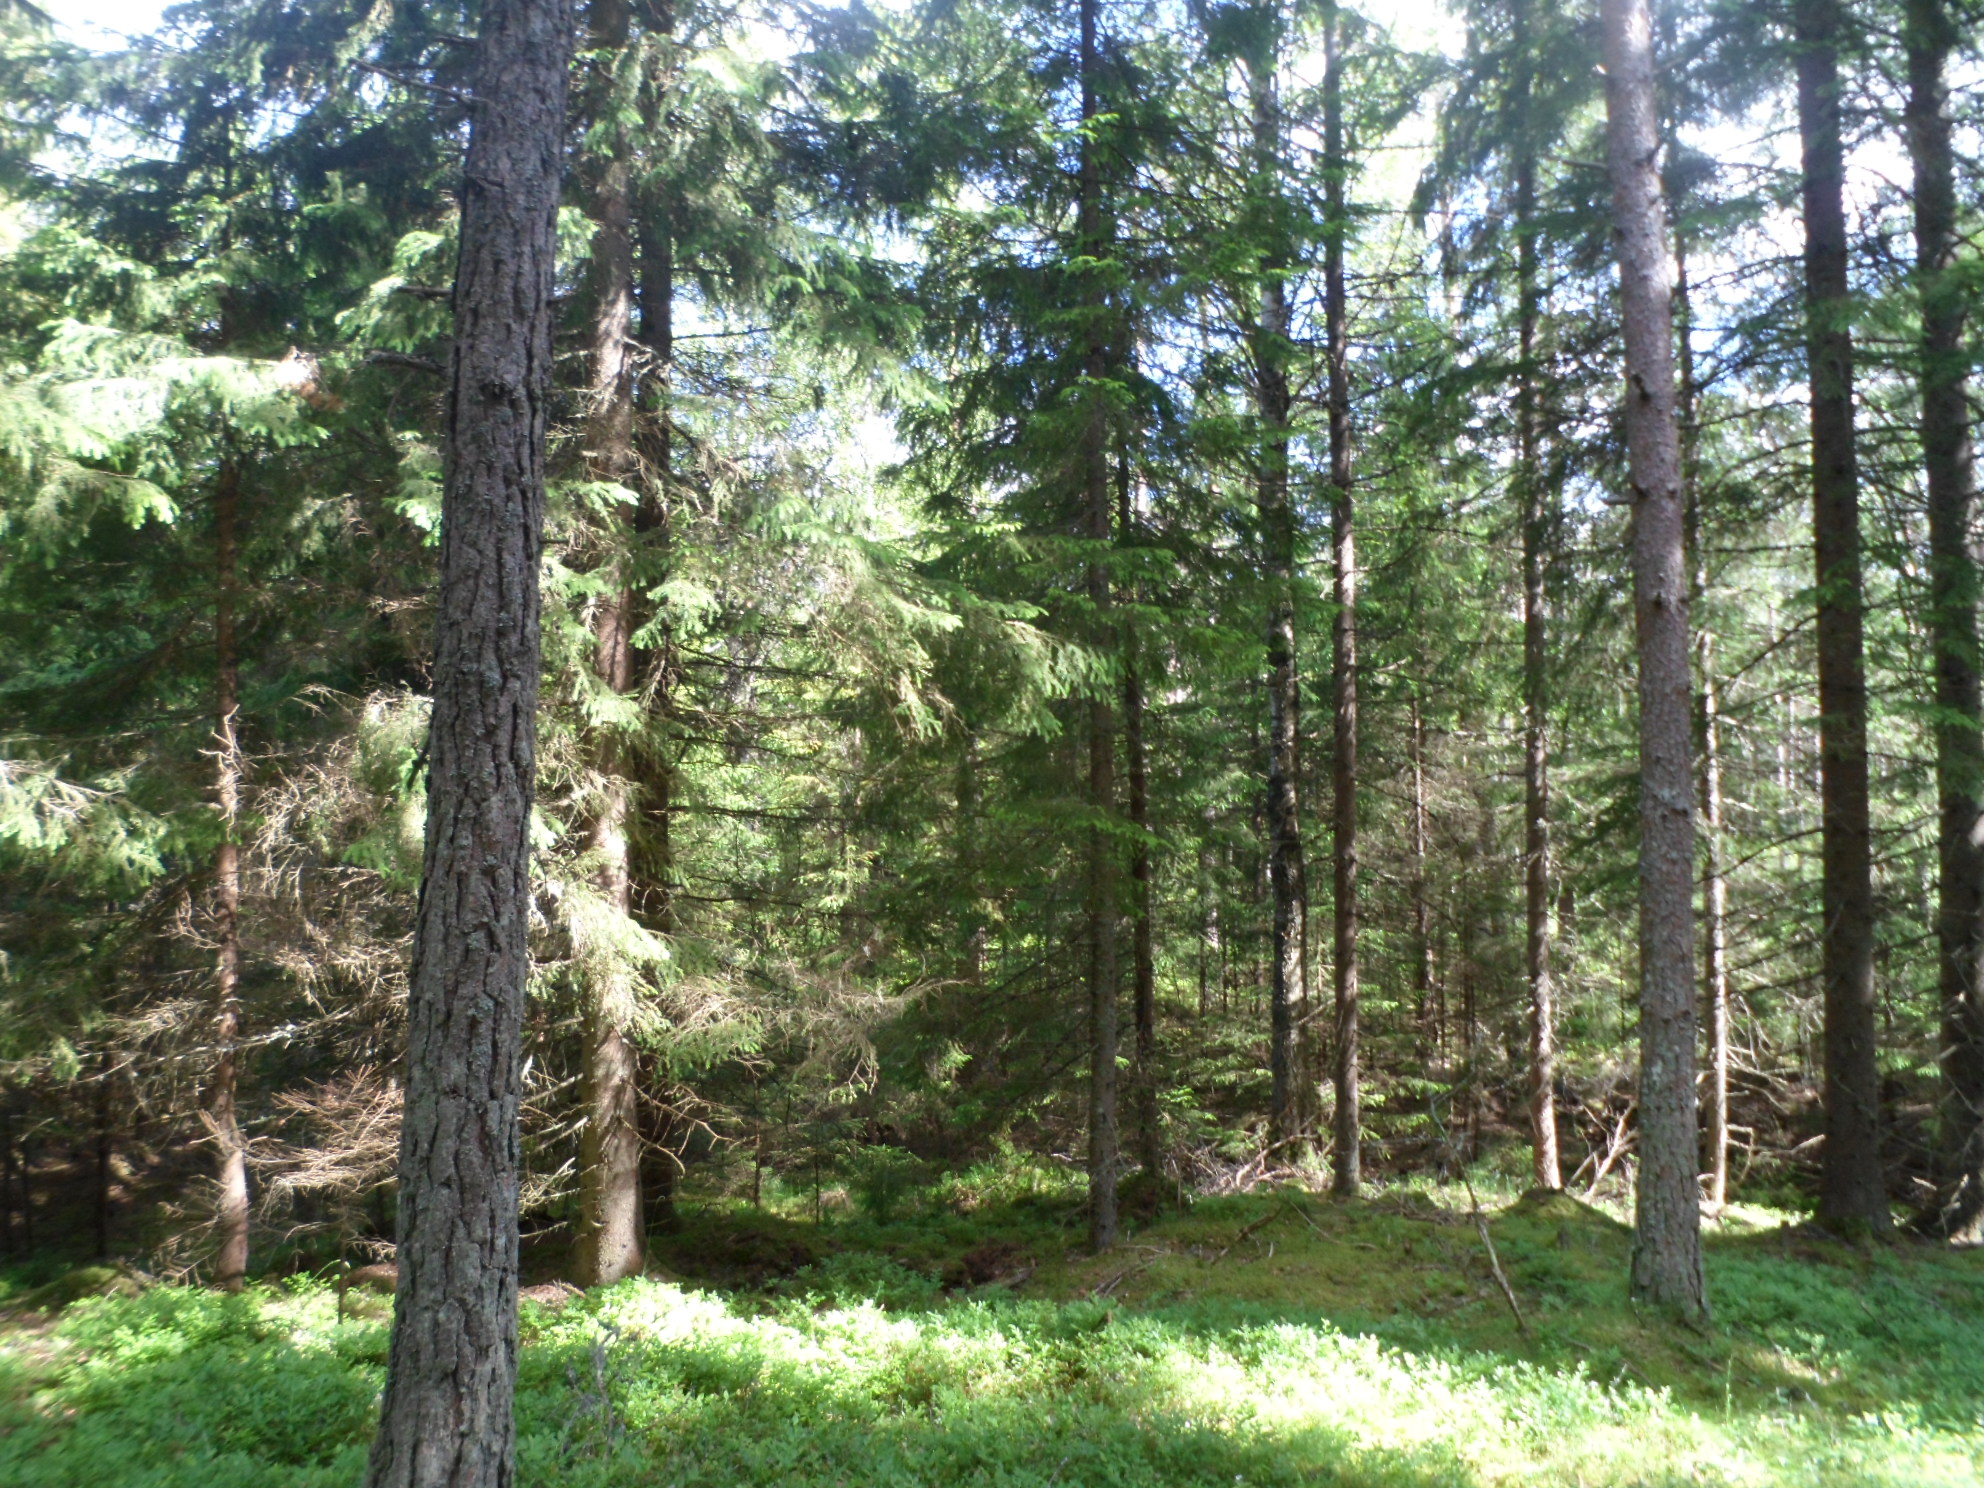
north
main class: Woodland
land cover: Spruce dominated coniferous woodland
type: boreal forest
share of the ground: 50 - 75 %
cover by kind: coniferous forest trees 60 %, lichens and mosses 20 %, shrubs 15 %, herbaceous plants 5 %
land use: Forestry
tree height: > 5 m
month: June
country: SE
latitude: 57.1414
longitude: 14.8386
